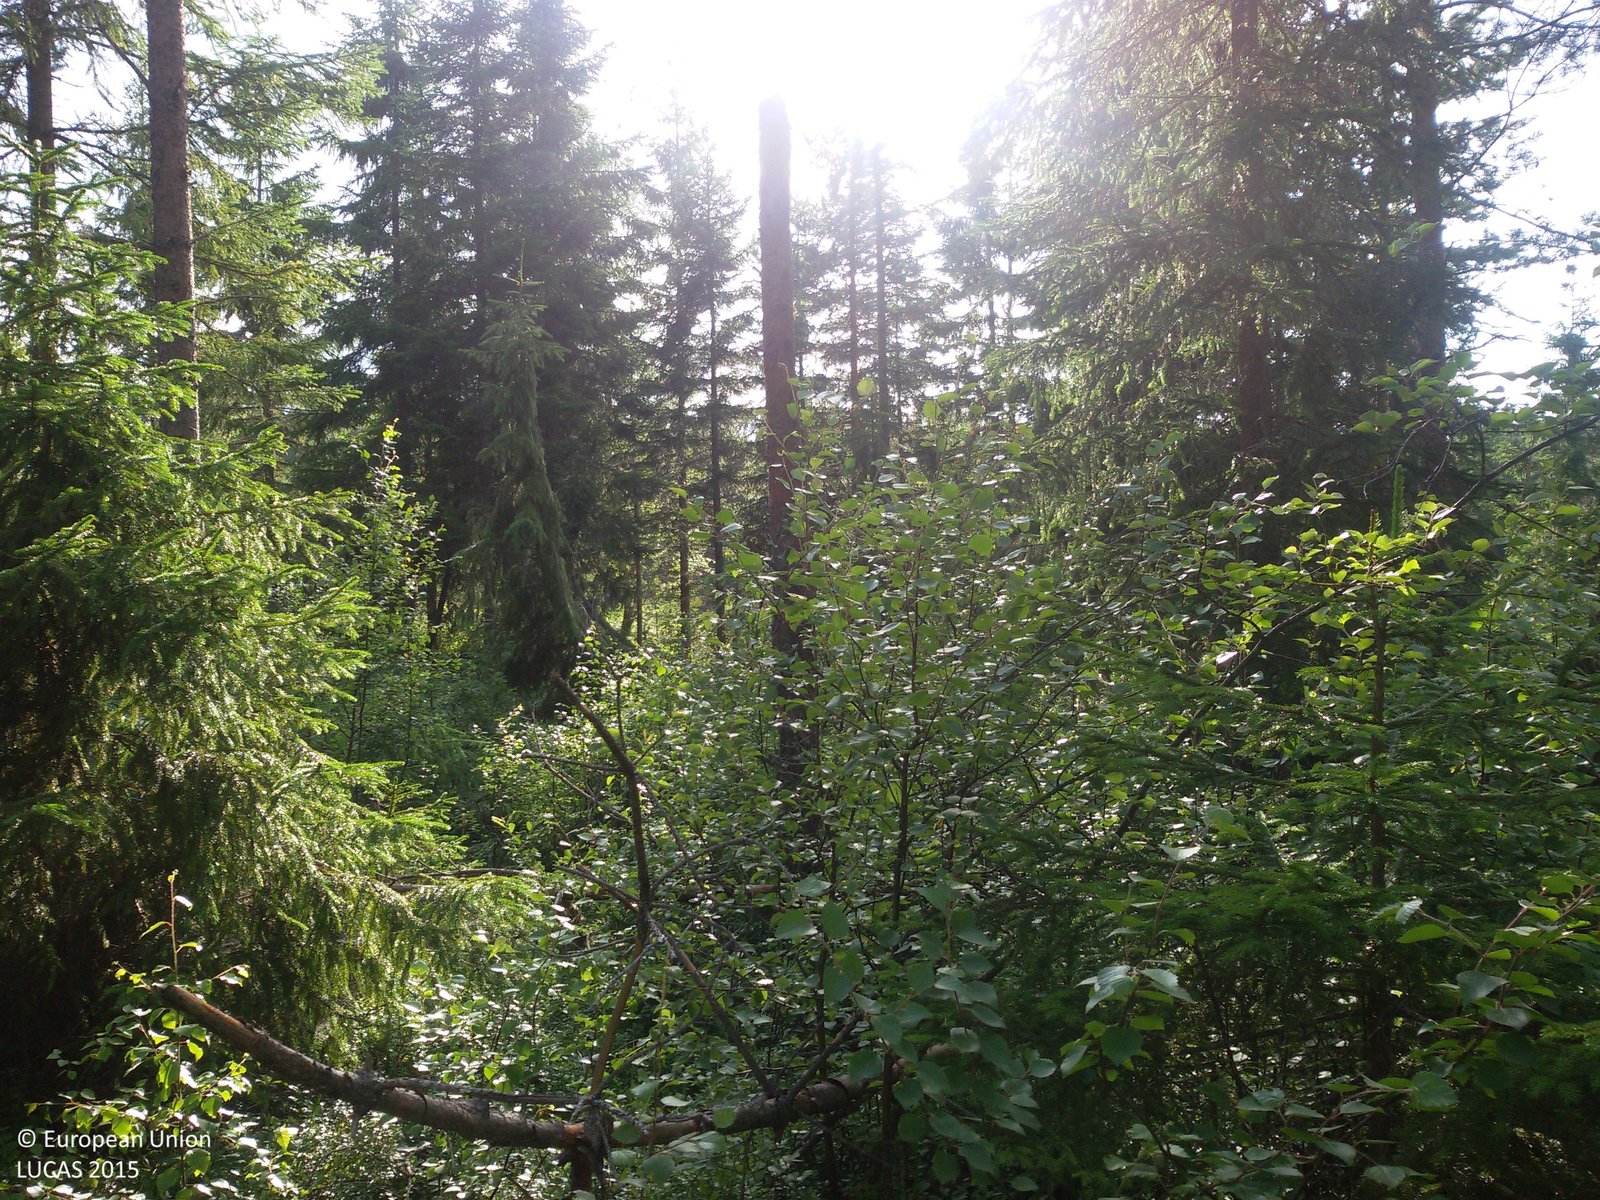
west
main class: Woodland
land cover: Pine dominated coniferous woodland
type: boreal forest
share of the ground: 50 - 75 %
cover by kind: coniferous forest trees 50 %, shrubs 30 %, broadleaved forest trees 10 %, lichens and mosses 10 %
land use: Forestry
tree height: > 5 m
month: July
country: SE
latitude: 60.5147
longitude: 15.2879
